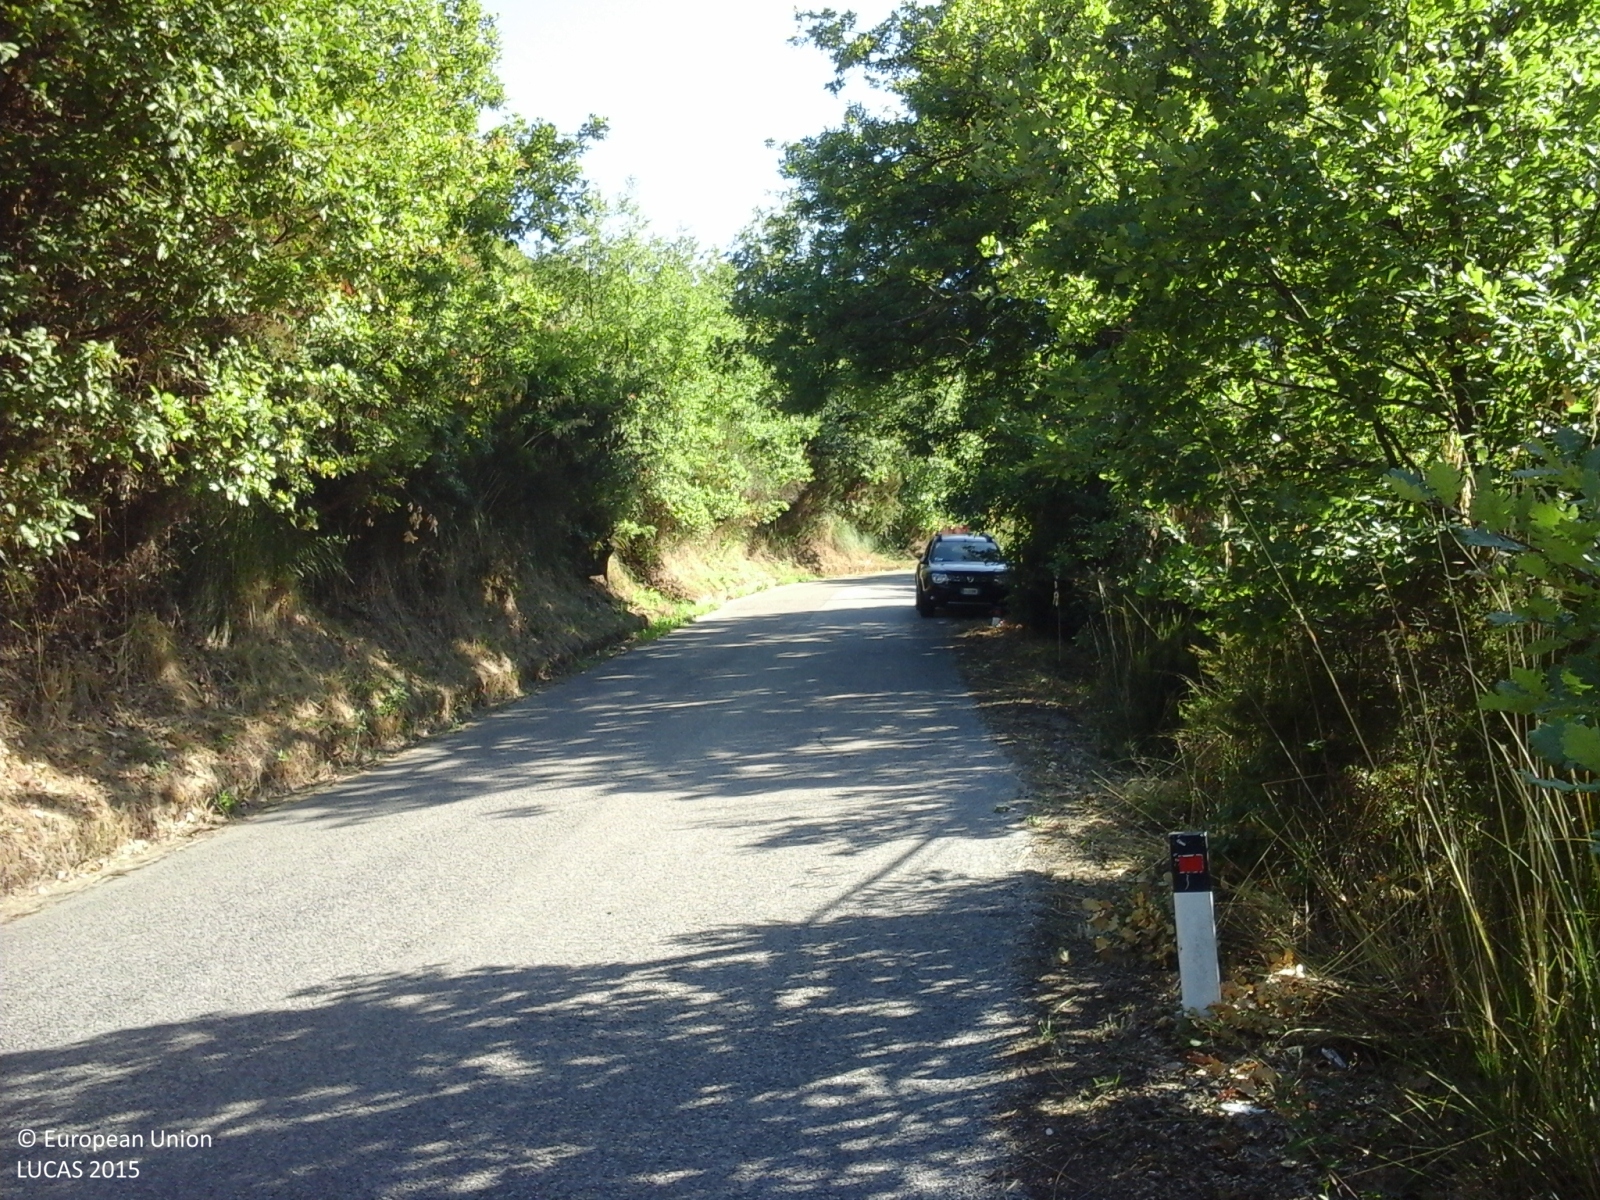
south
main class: Shrubland
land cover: Shrubland with sparse tree cover
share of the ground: > 75 %
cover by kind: shrubs 75 %, herbaceous plants 20 %, broadleaved forest trees 5 %
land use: Abandoned areas
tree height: > 5 m
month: August
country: IT
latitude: 40.2620
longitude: 15.0923
